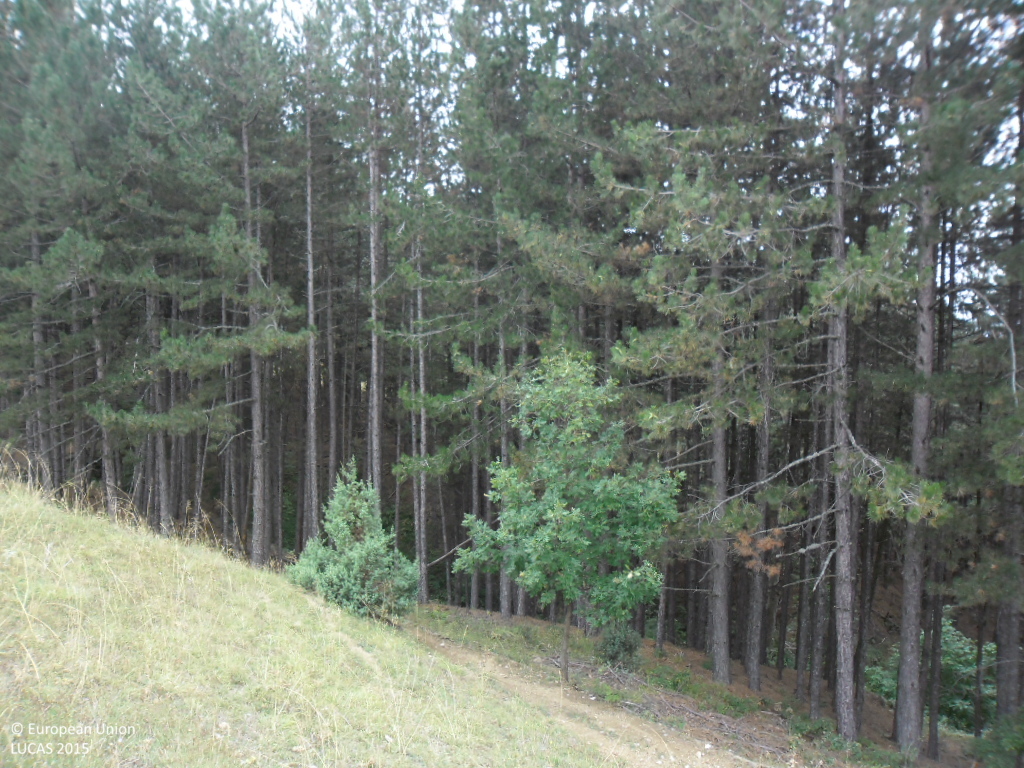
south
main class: Grassland
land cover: Grassland with sparse tree/shrub cover
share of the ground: > 75 %
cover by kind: herbaceous plants 90 %, broadleaved forest trees 5 %, shrubs 5 %
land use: Agriculture (excluding fallow land and kitchen gardens)
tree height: < 5 m
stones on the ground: < 10 %
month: September
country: BG
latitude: 42.0264
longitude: 23.1782
